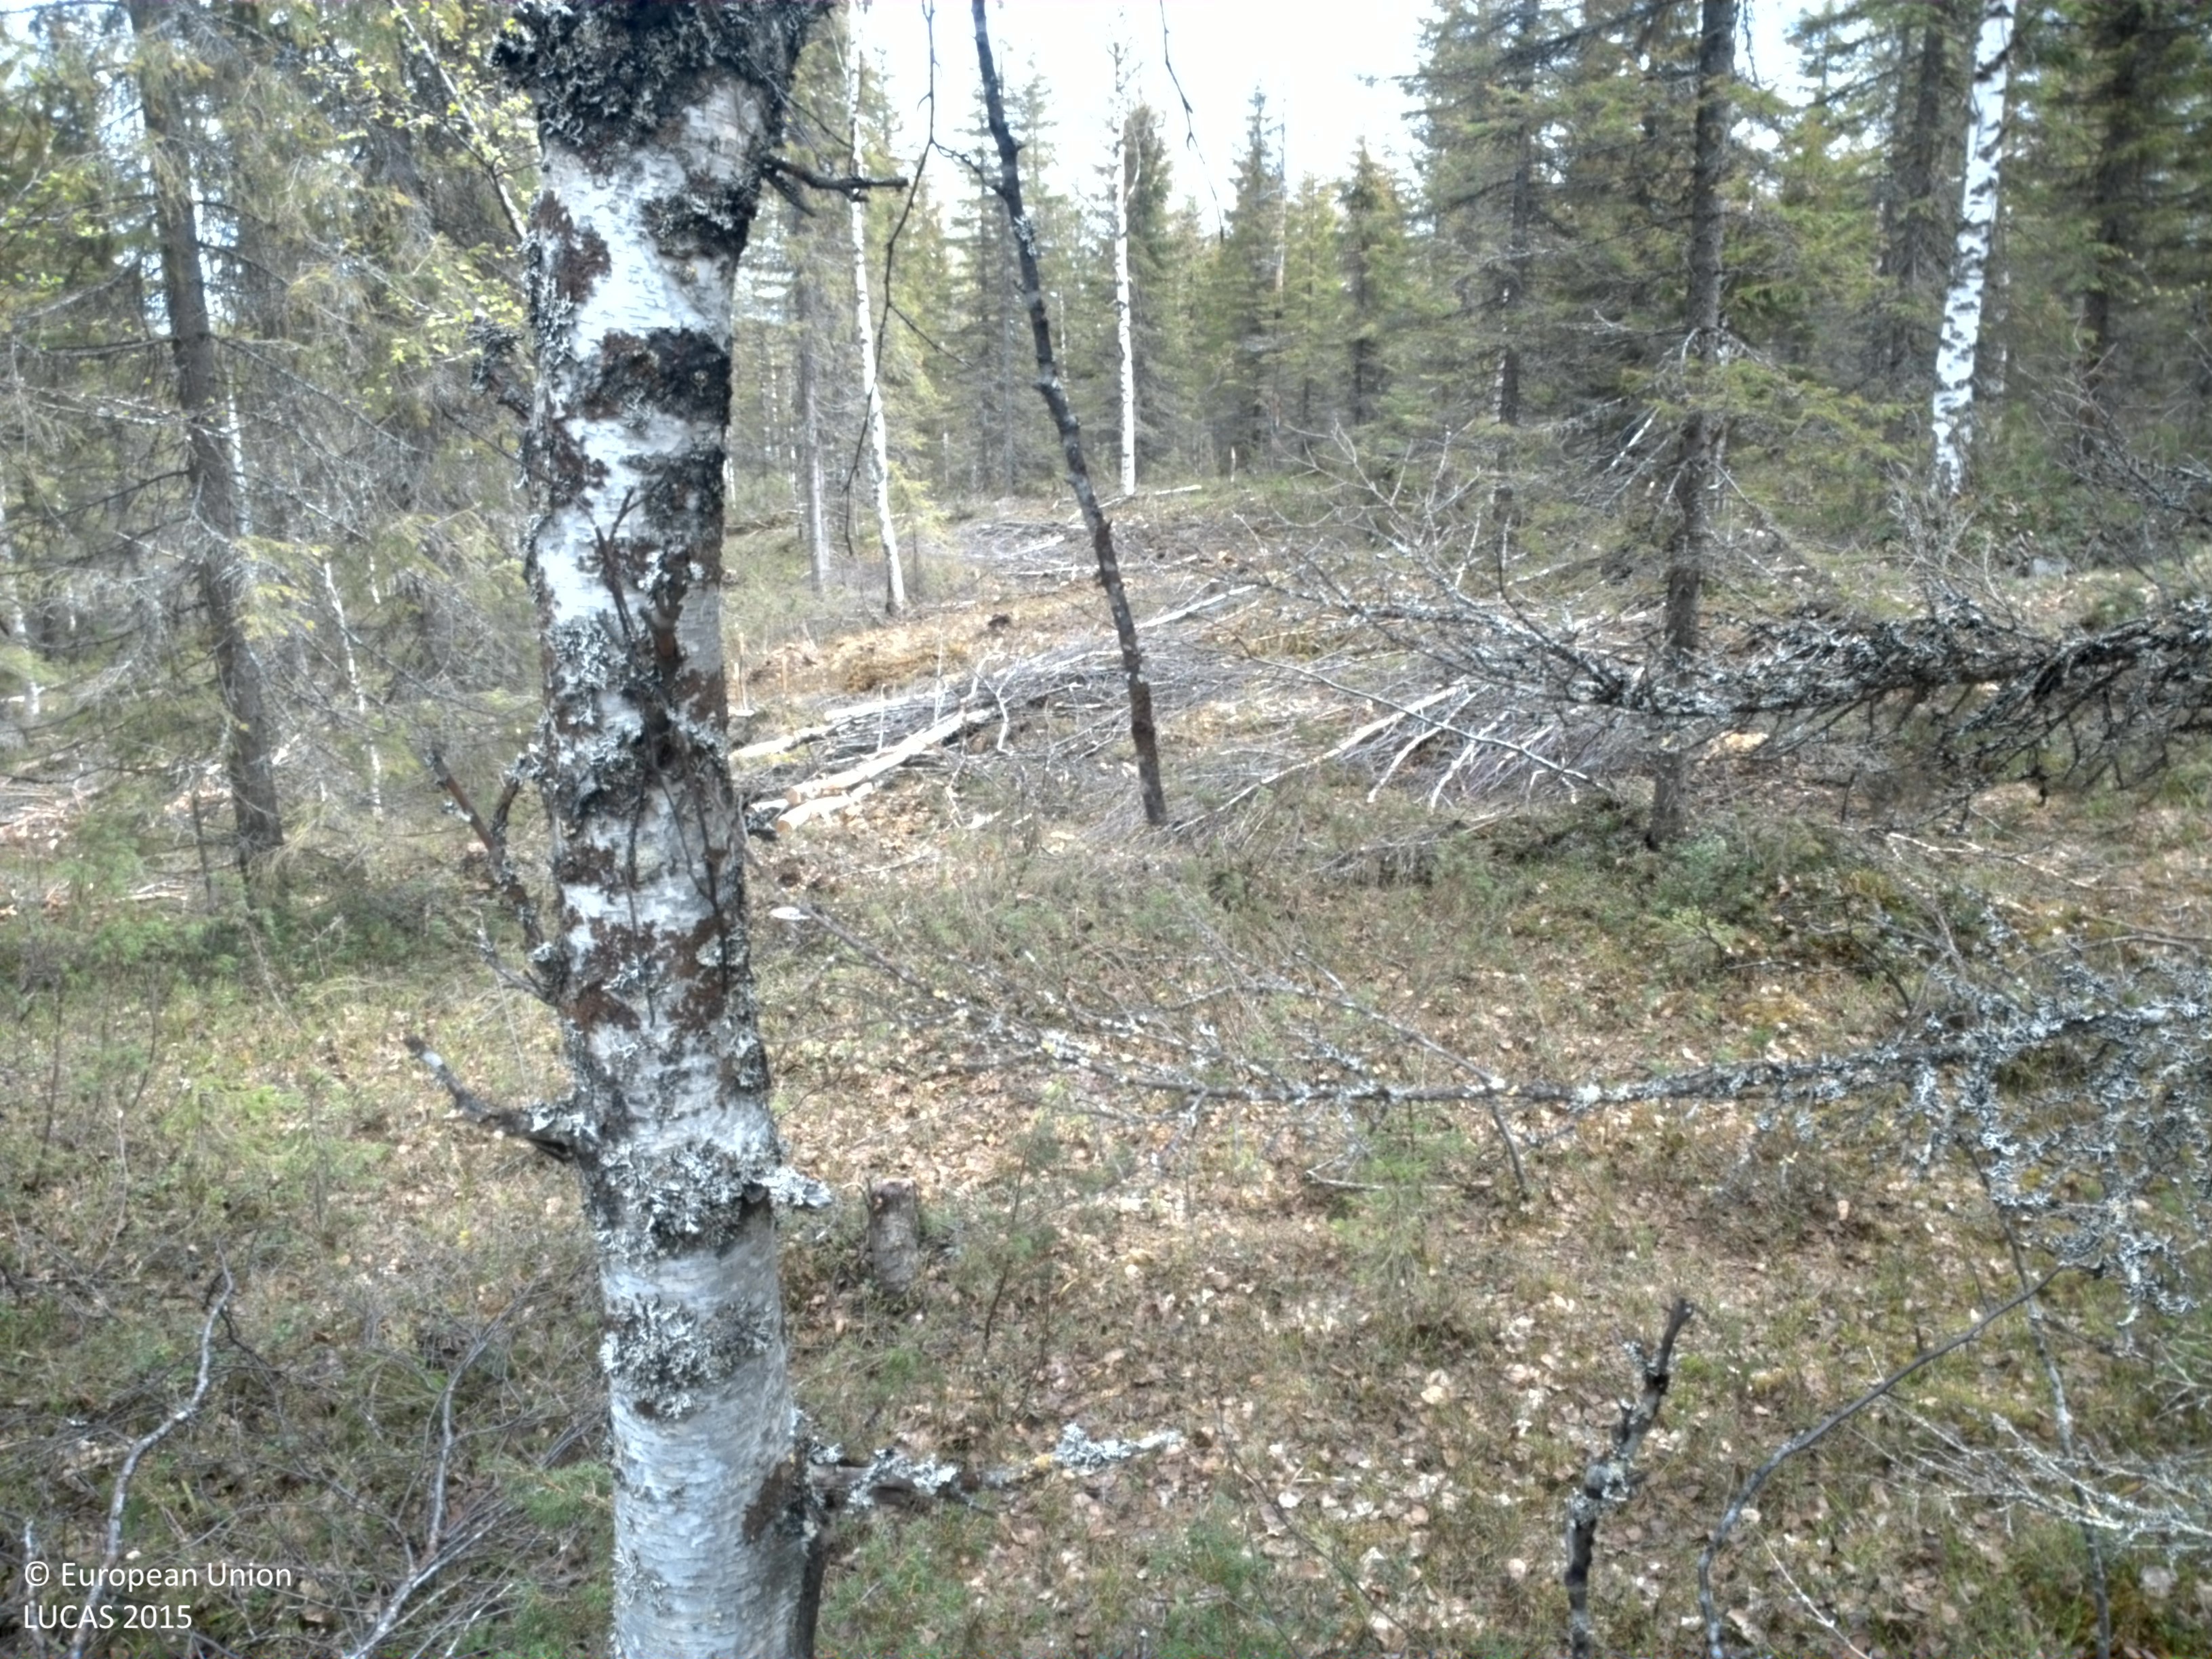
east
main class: Woodland
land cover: Spruce dominated mixed woodland
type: boreal forest
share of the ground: 50 - 75 %
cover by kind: coniferous forest trees 55 %, shrubs 25 %, broadleaved forest trees 20 %
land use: Forestry
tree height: > 5 m
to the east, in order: Spruce dominated mixed woodland; Rivers and streams; Spruce dominated mixed woodland
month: June
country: SE
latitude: 66.4982
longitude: 23.3531
